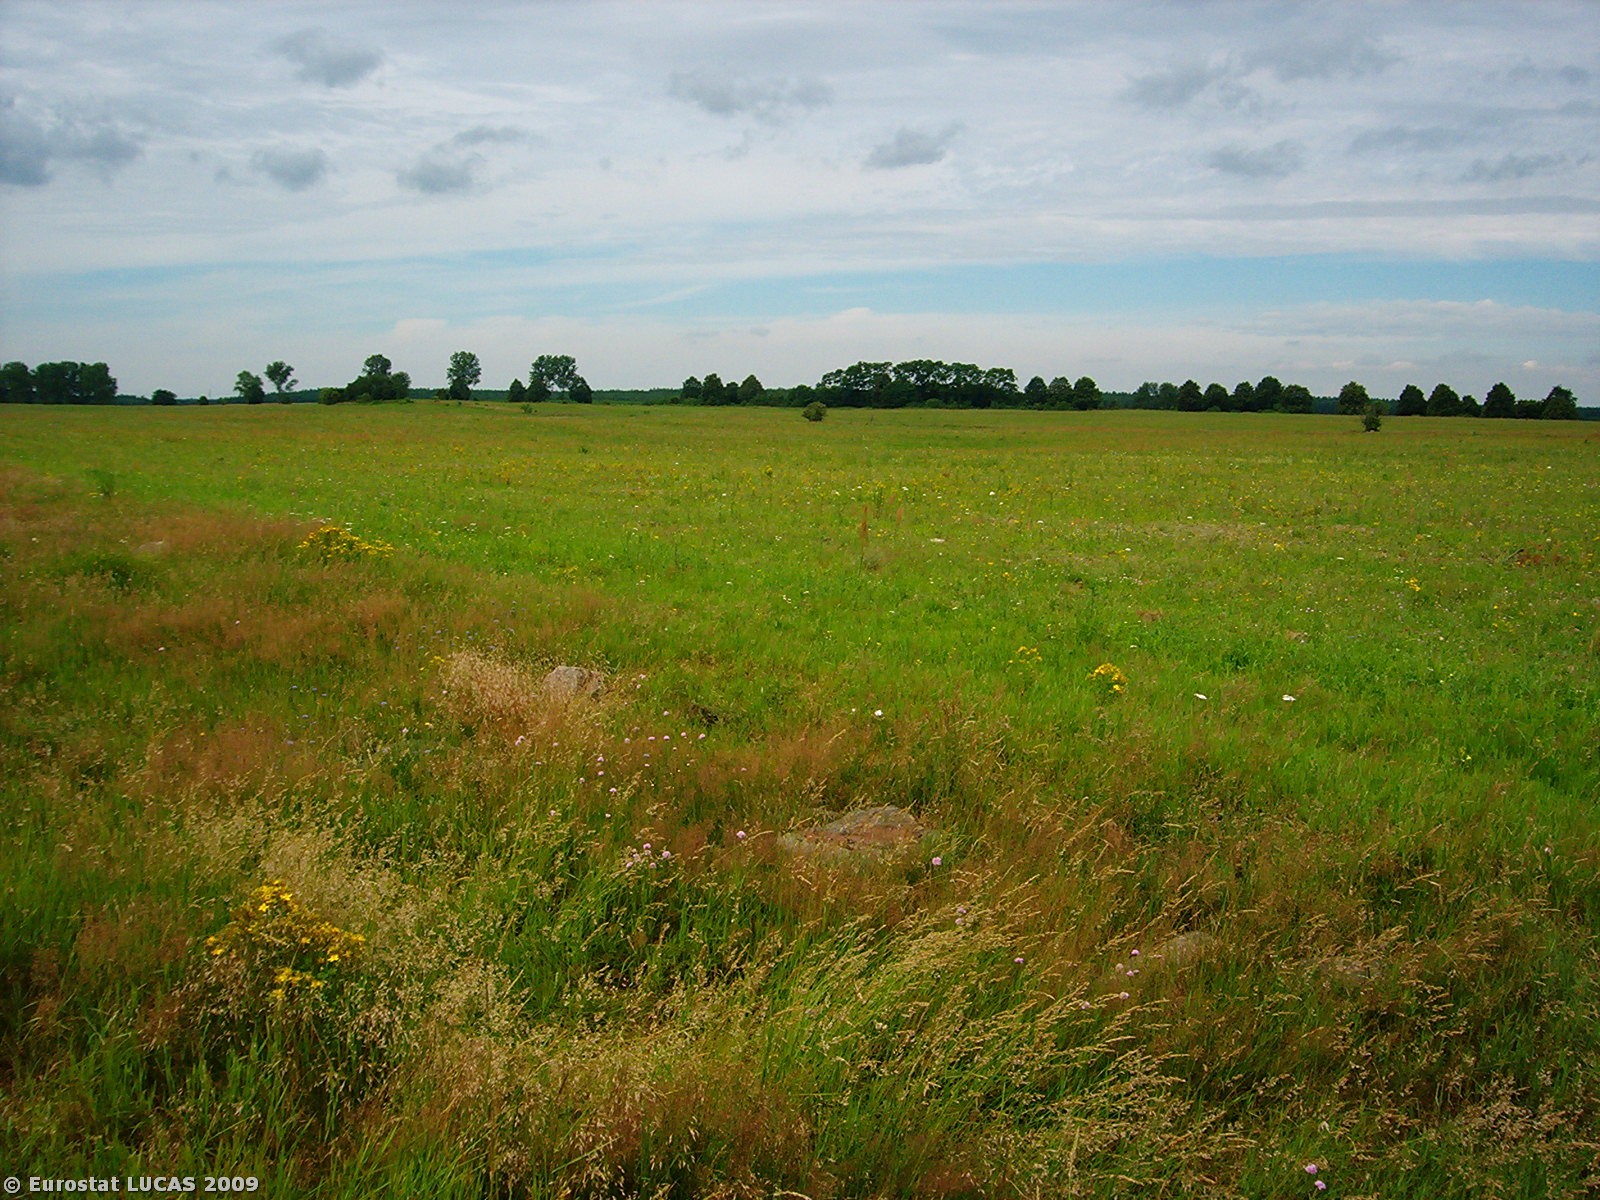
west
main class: Cropland
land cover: Triticale
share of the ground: > 75 %
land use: Agriculture (excluding fallow land and kitchen gardens)
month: July
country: PL
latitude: 52.3184
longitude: 15.1817
